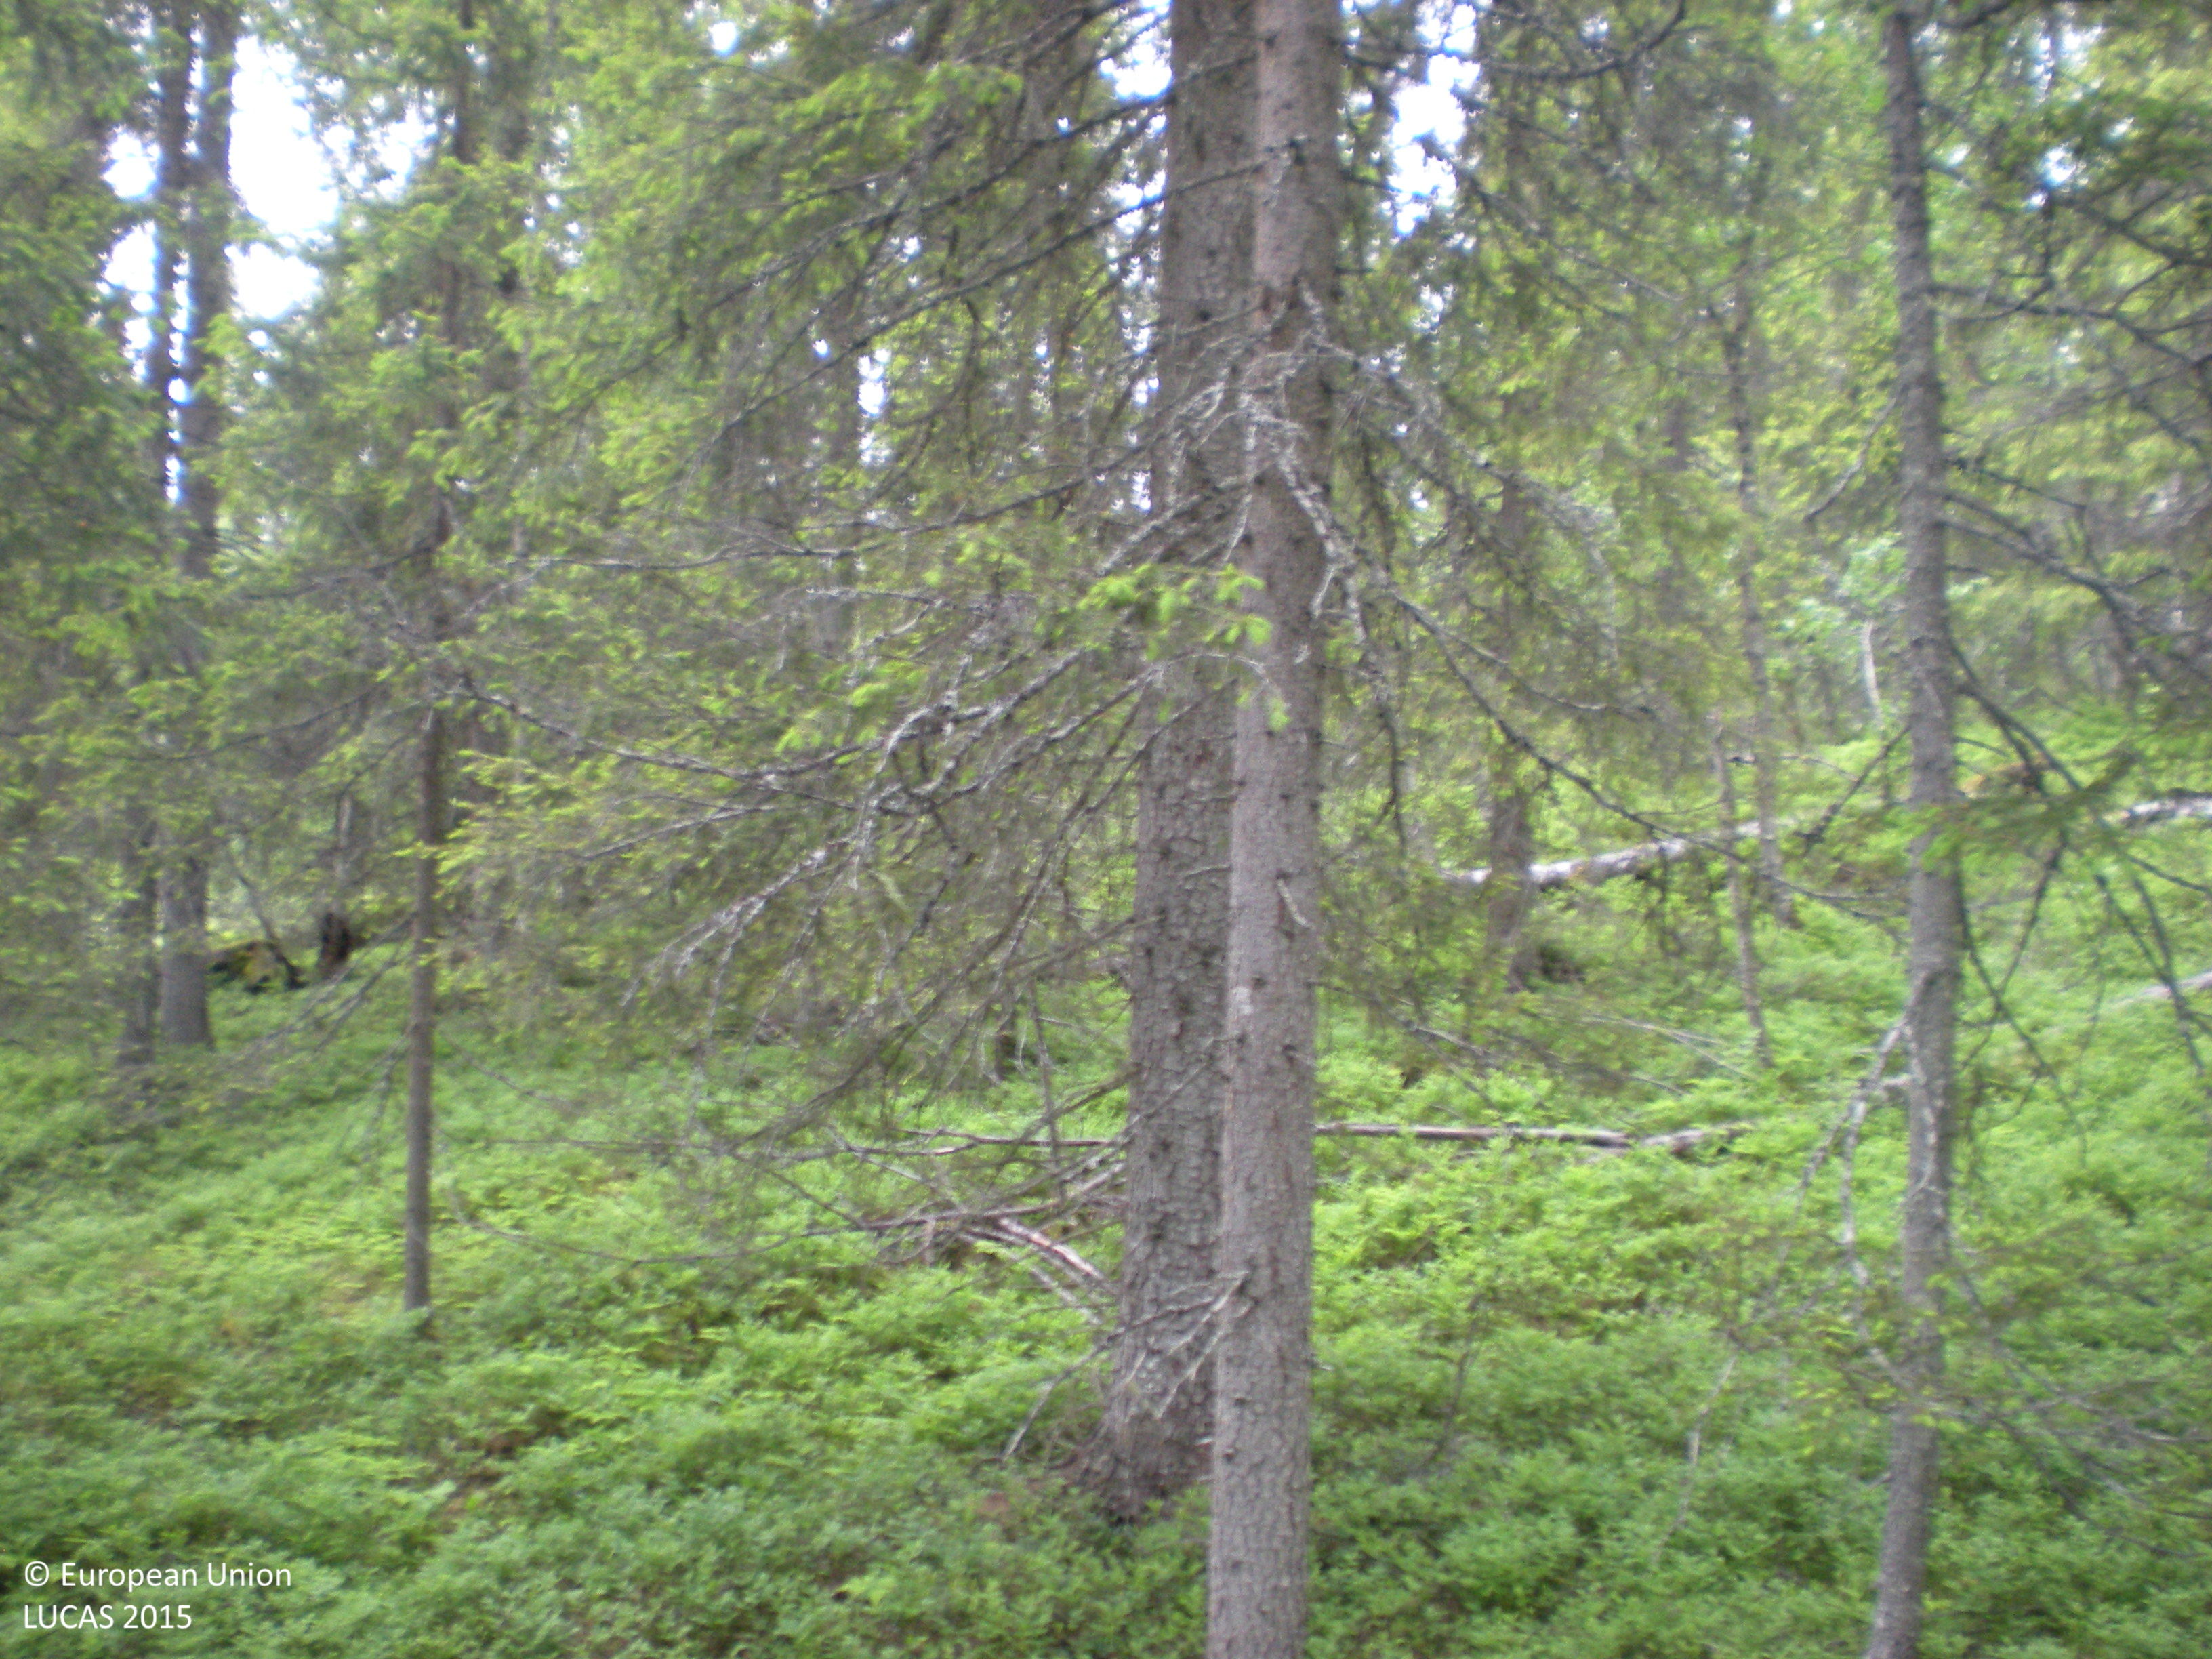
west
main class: Woodland
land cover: Spruce dominated coniferous woodland
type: boreal forest
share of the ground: 50 - 75 %
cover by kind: coniferous forest trees 60 %, shrubs 20 %, broadleaved forest trees 10 %, lichens and mosses 10 %
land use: Forestry
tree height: > 5 m
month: July
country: SE
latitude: 65.4137
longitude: 17.2198
